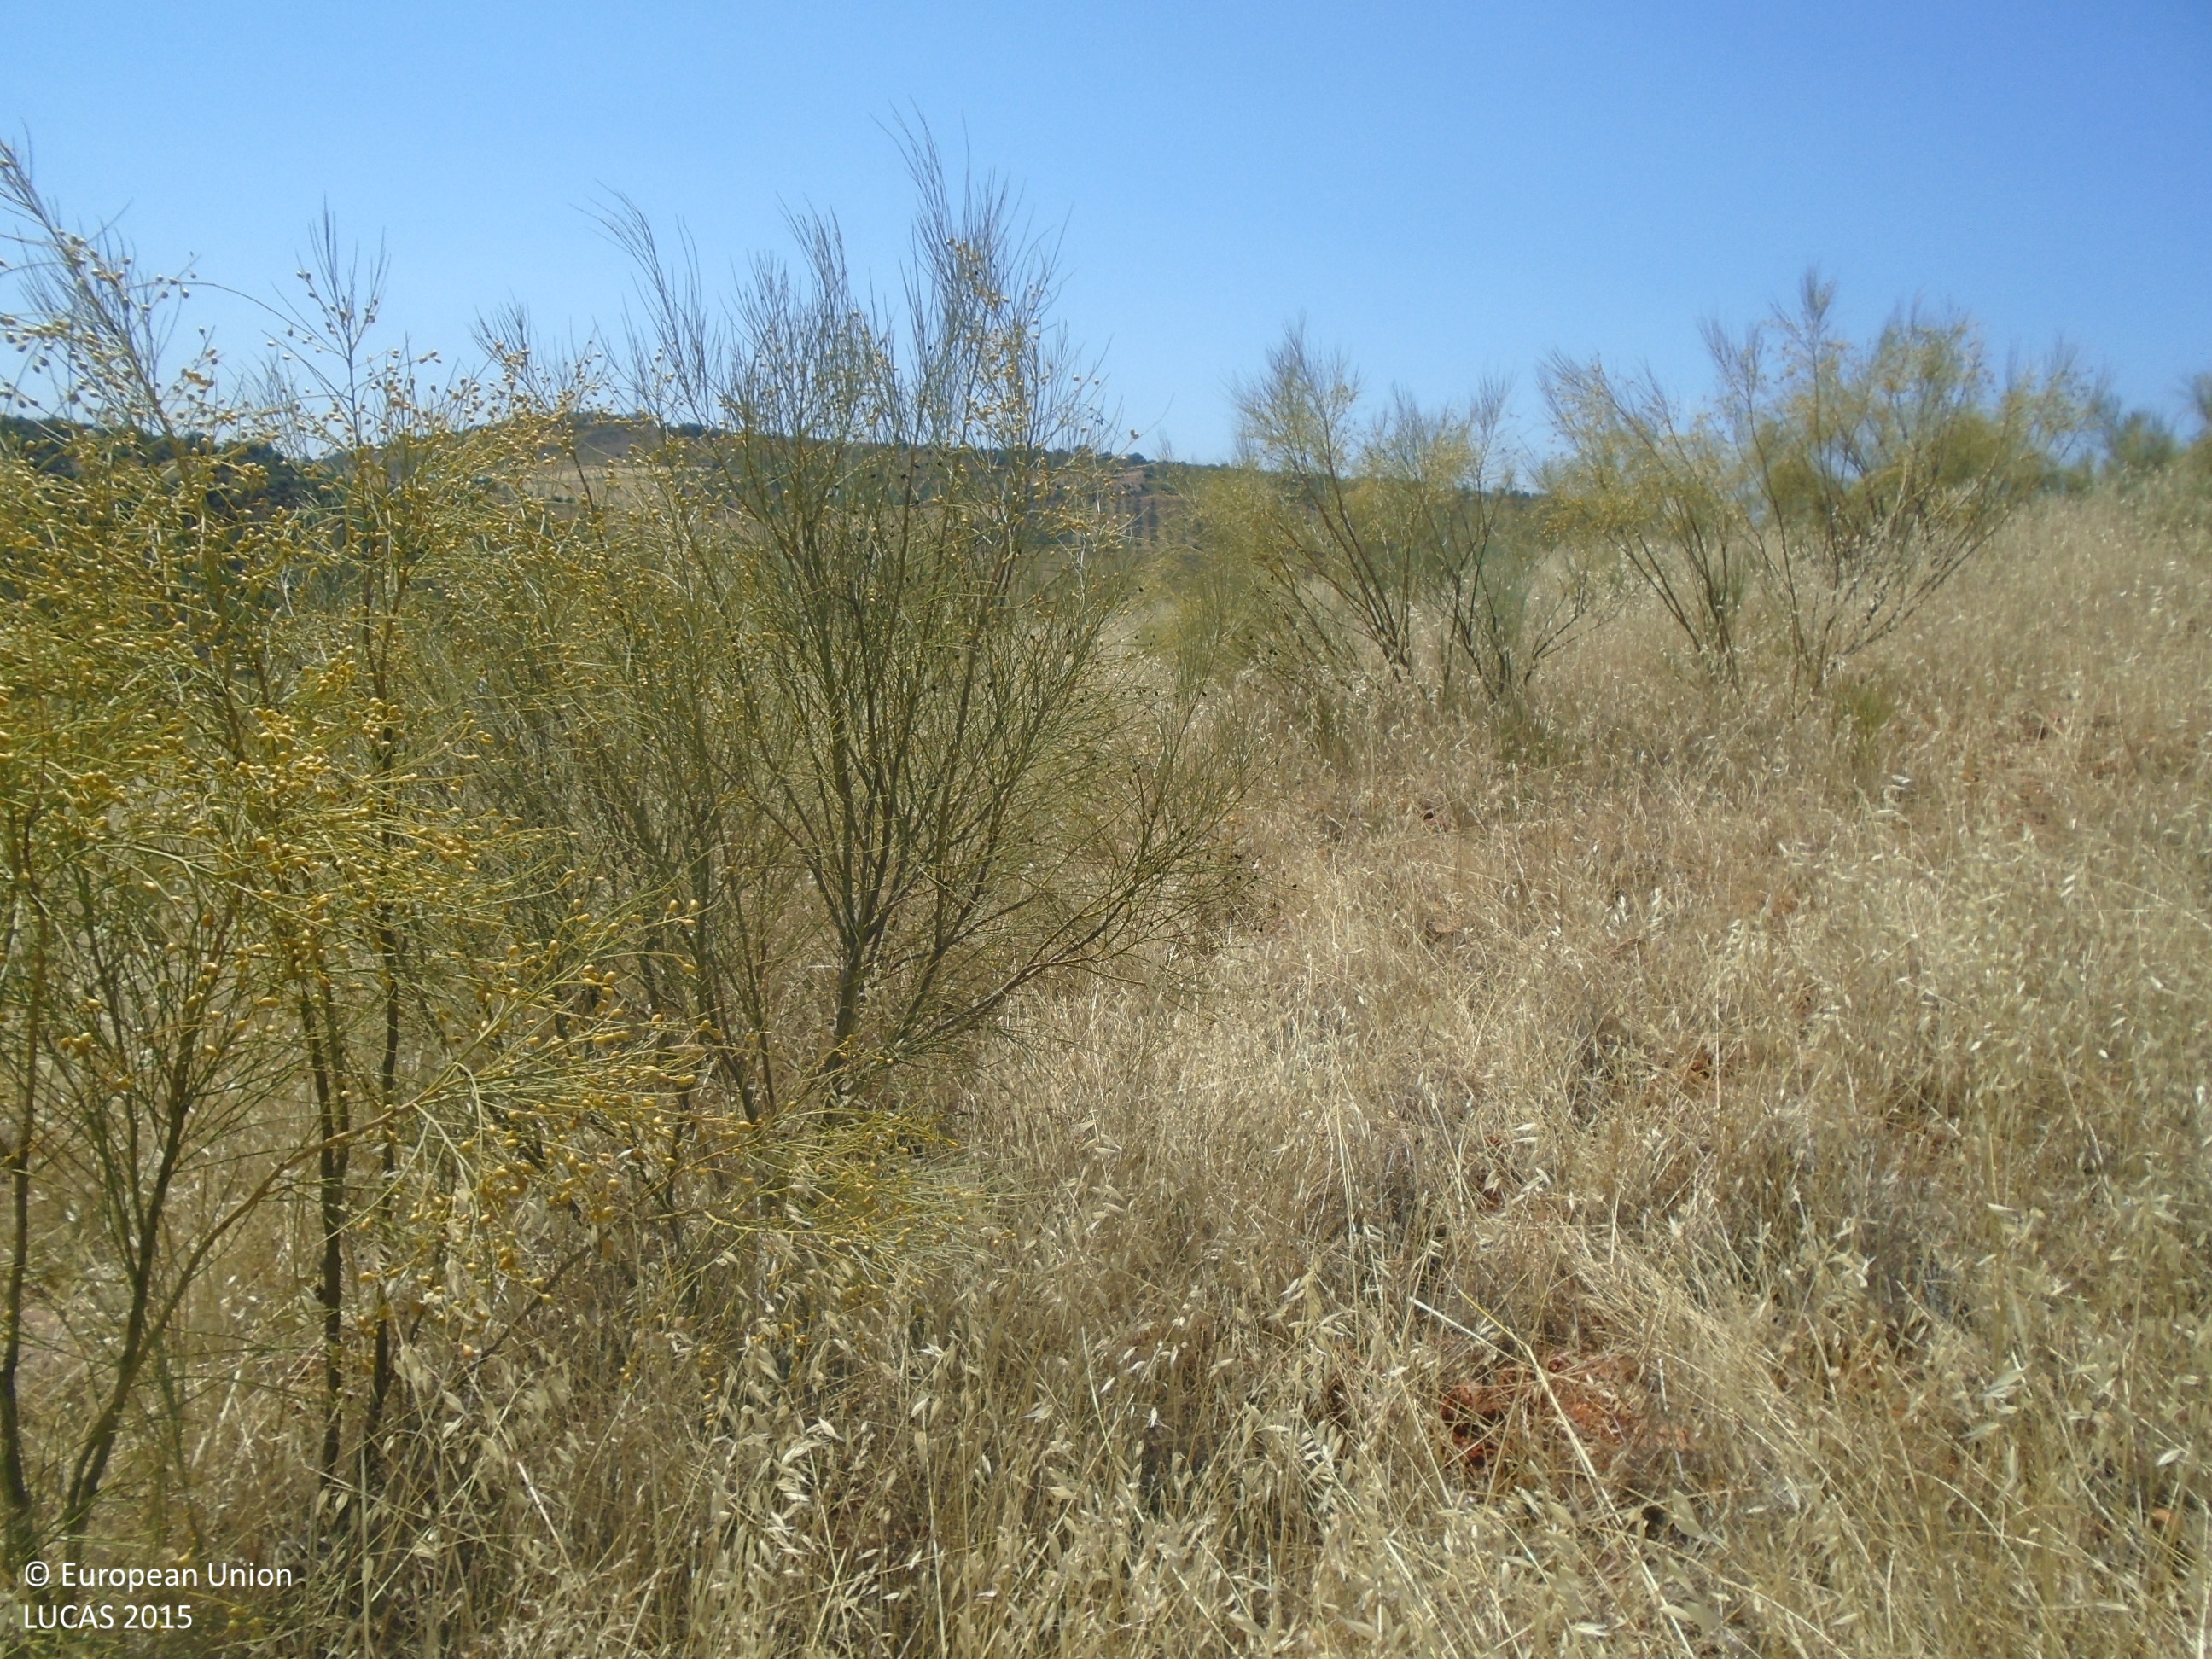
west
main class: Shrubland
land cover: Shrubland without tree cover
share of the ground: > 75 %
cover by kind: herbaceous plants 80 %, shrubs 20 %
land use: Semi-natural and natural areas not in use
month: July
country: ES
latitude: 39.6614
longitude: -4.9769
